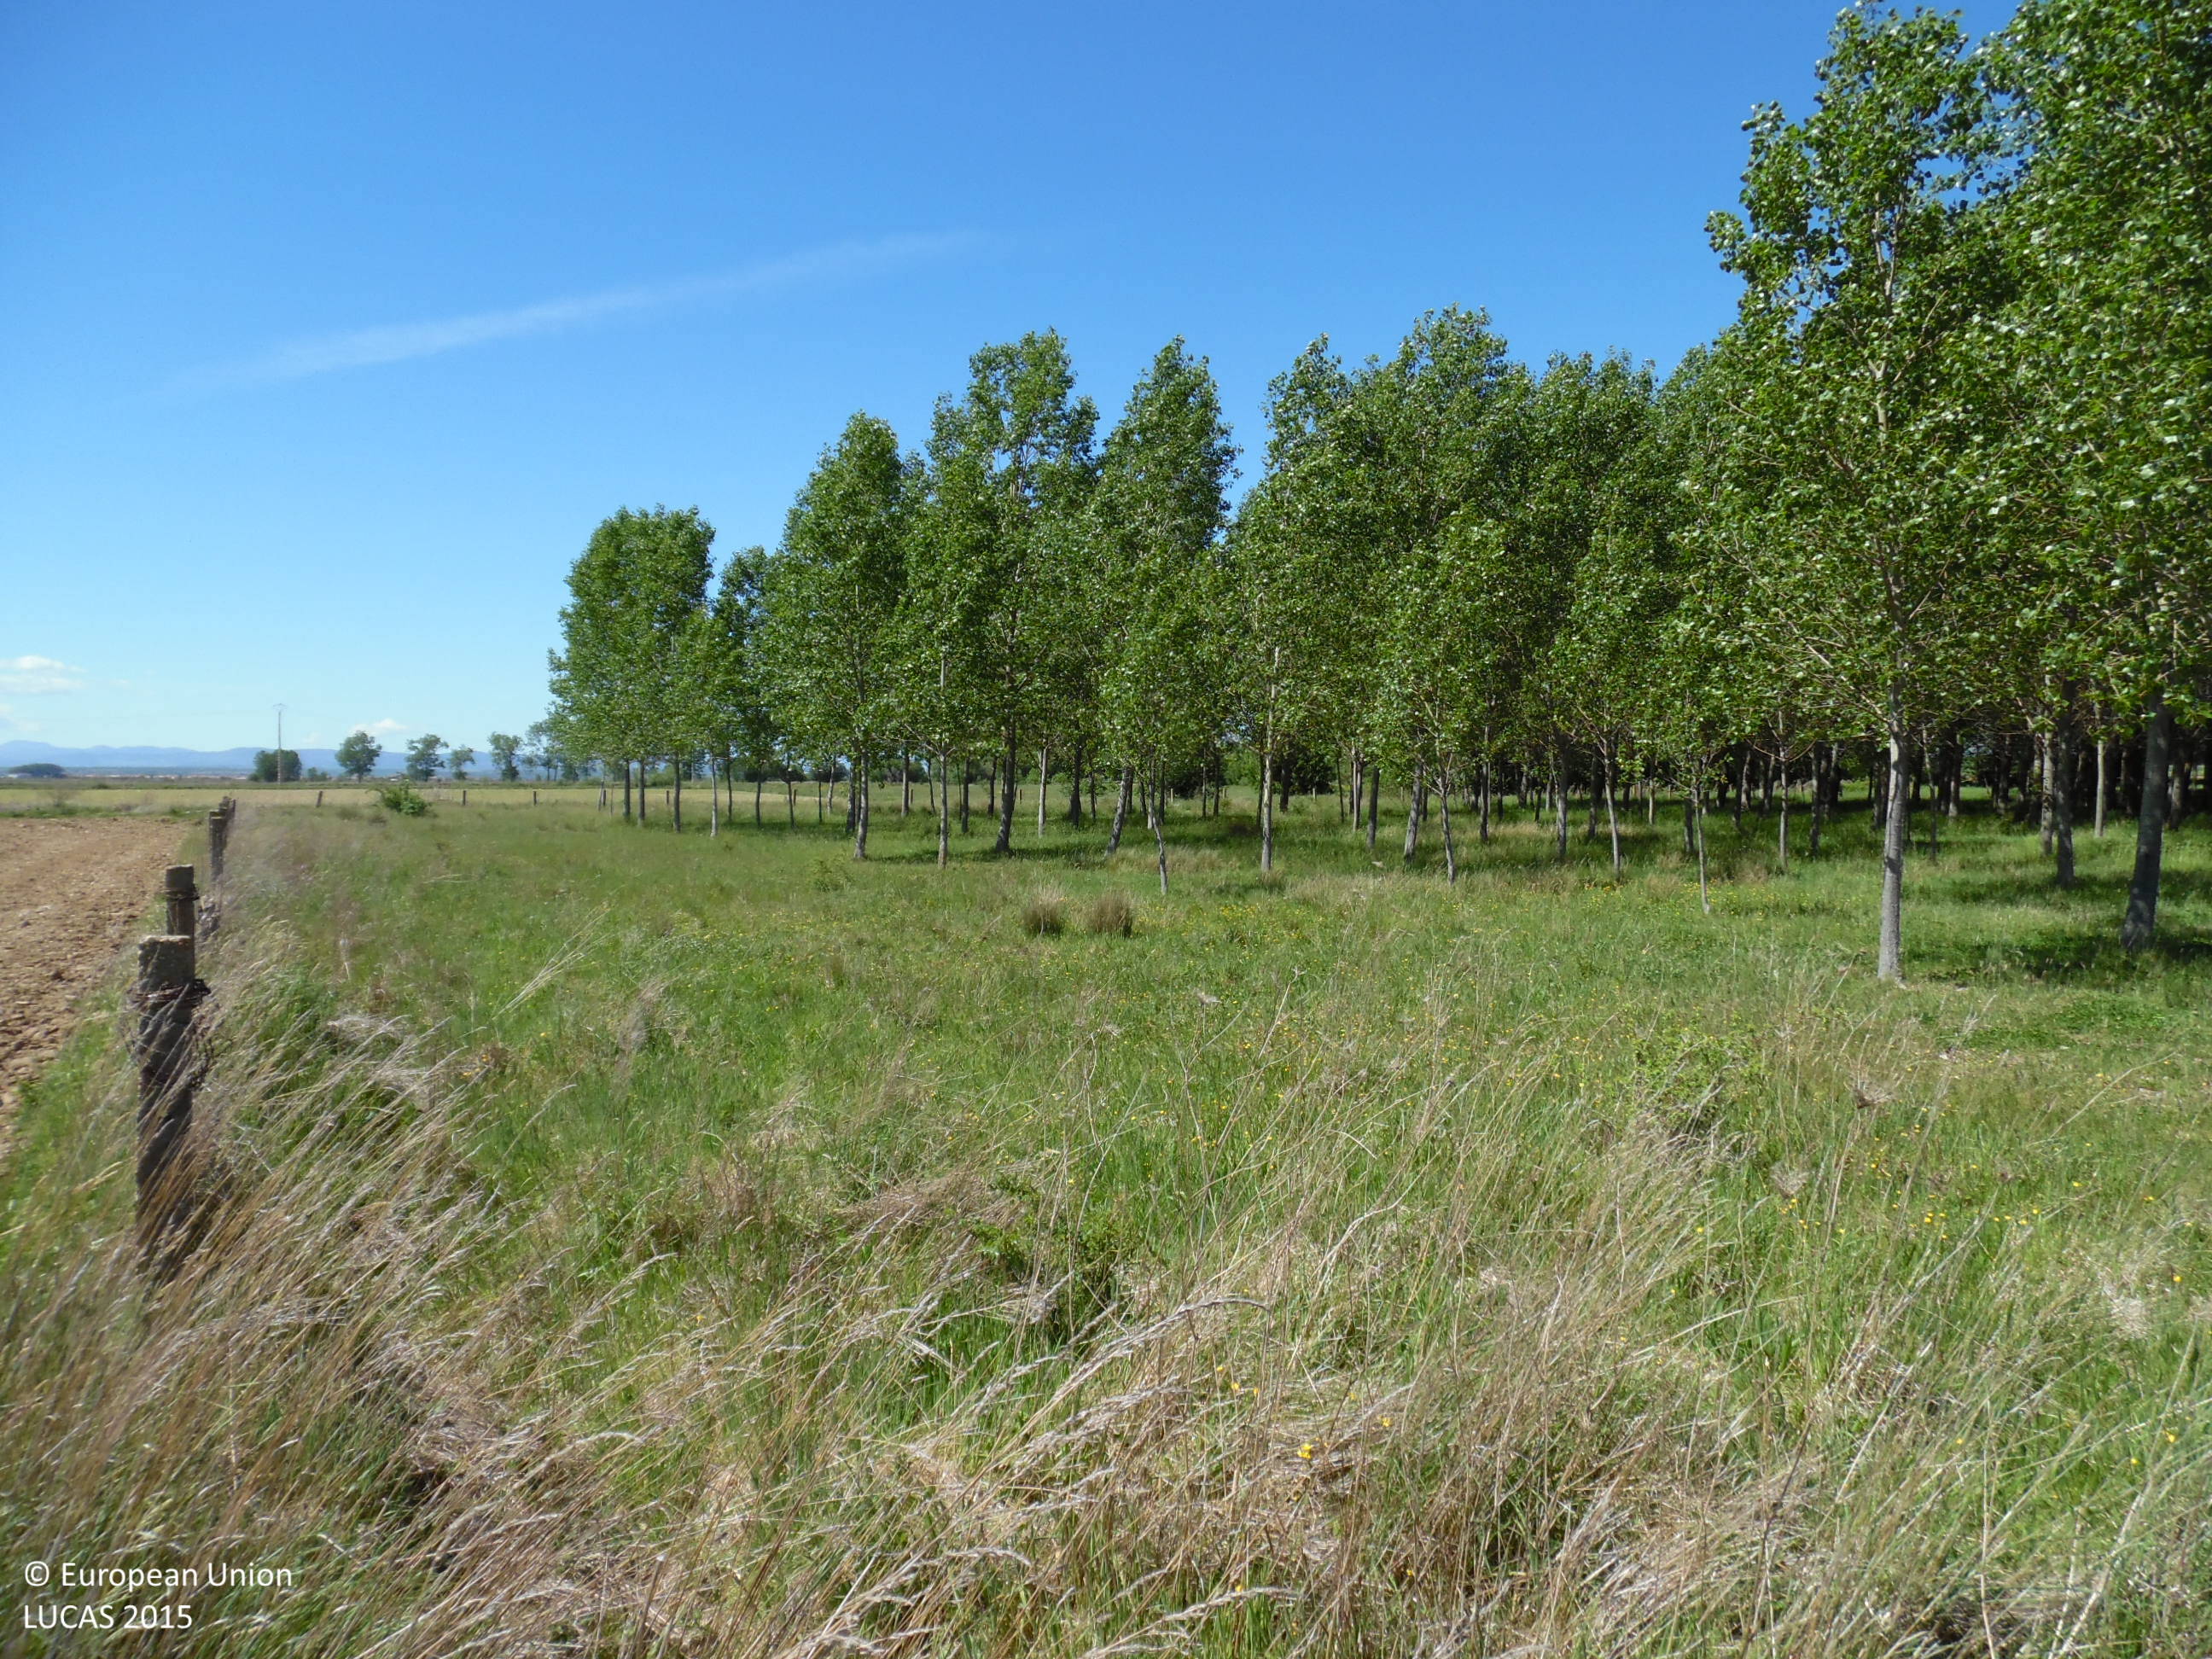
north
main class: Grassland
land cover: Grassland with sparse tree/shrub cover
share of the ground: 10 - 25 %
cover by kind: herbaceous plants 95 %, broadleaved forest trees 5 %
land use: Forestry
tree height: > 5 m
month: May
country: ES
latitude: 42.5262
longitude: -5.7927
